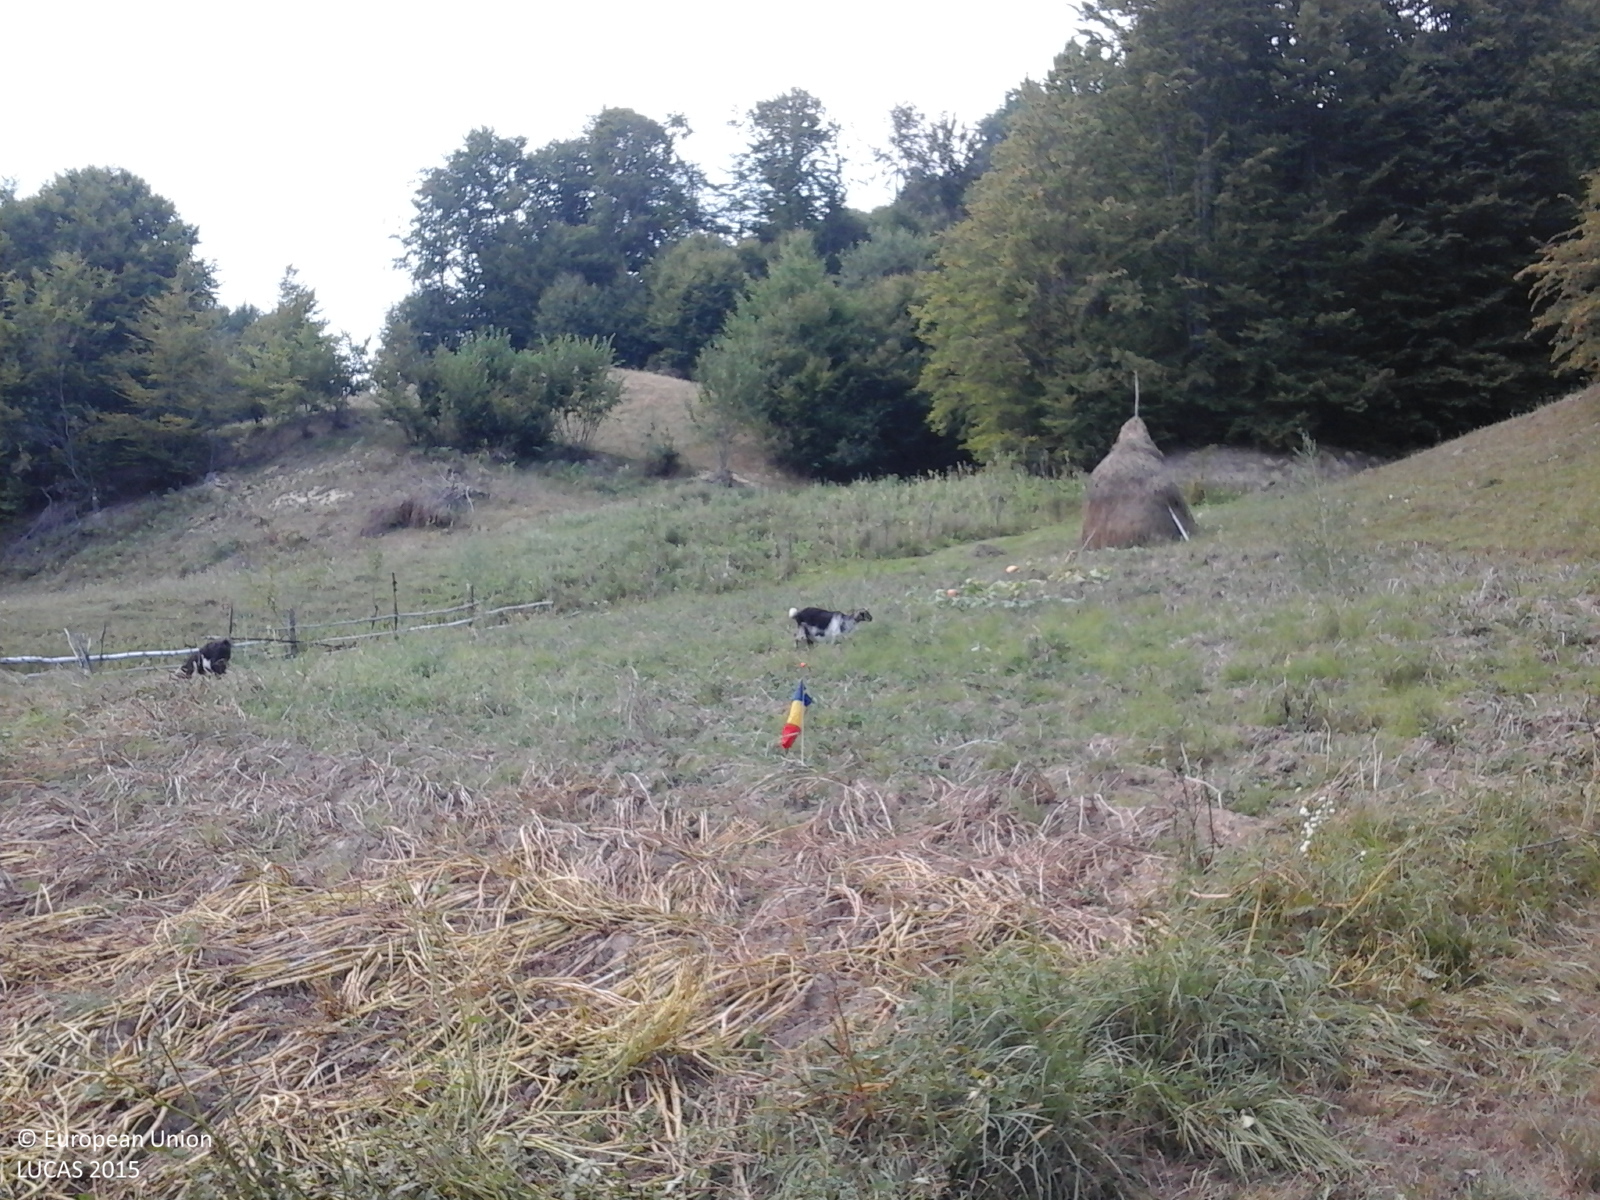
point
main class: Cropland
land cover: Potatoes
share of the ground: > 75 %
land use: Agriculture (excluding fallow land and kitchen gardens)
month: September
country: RO
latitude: 47.3835
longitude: 24.2475
